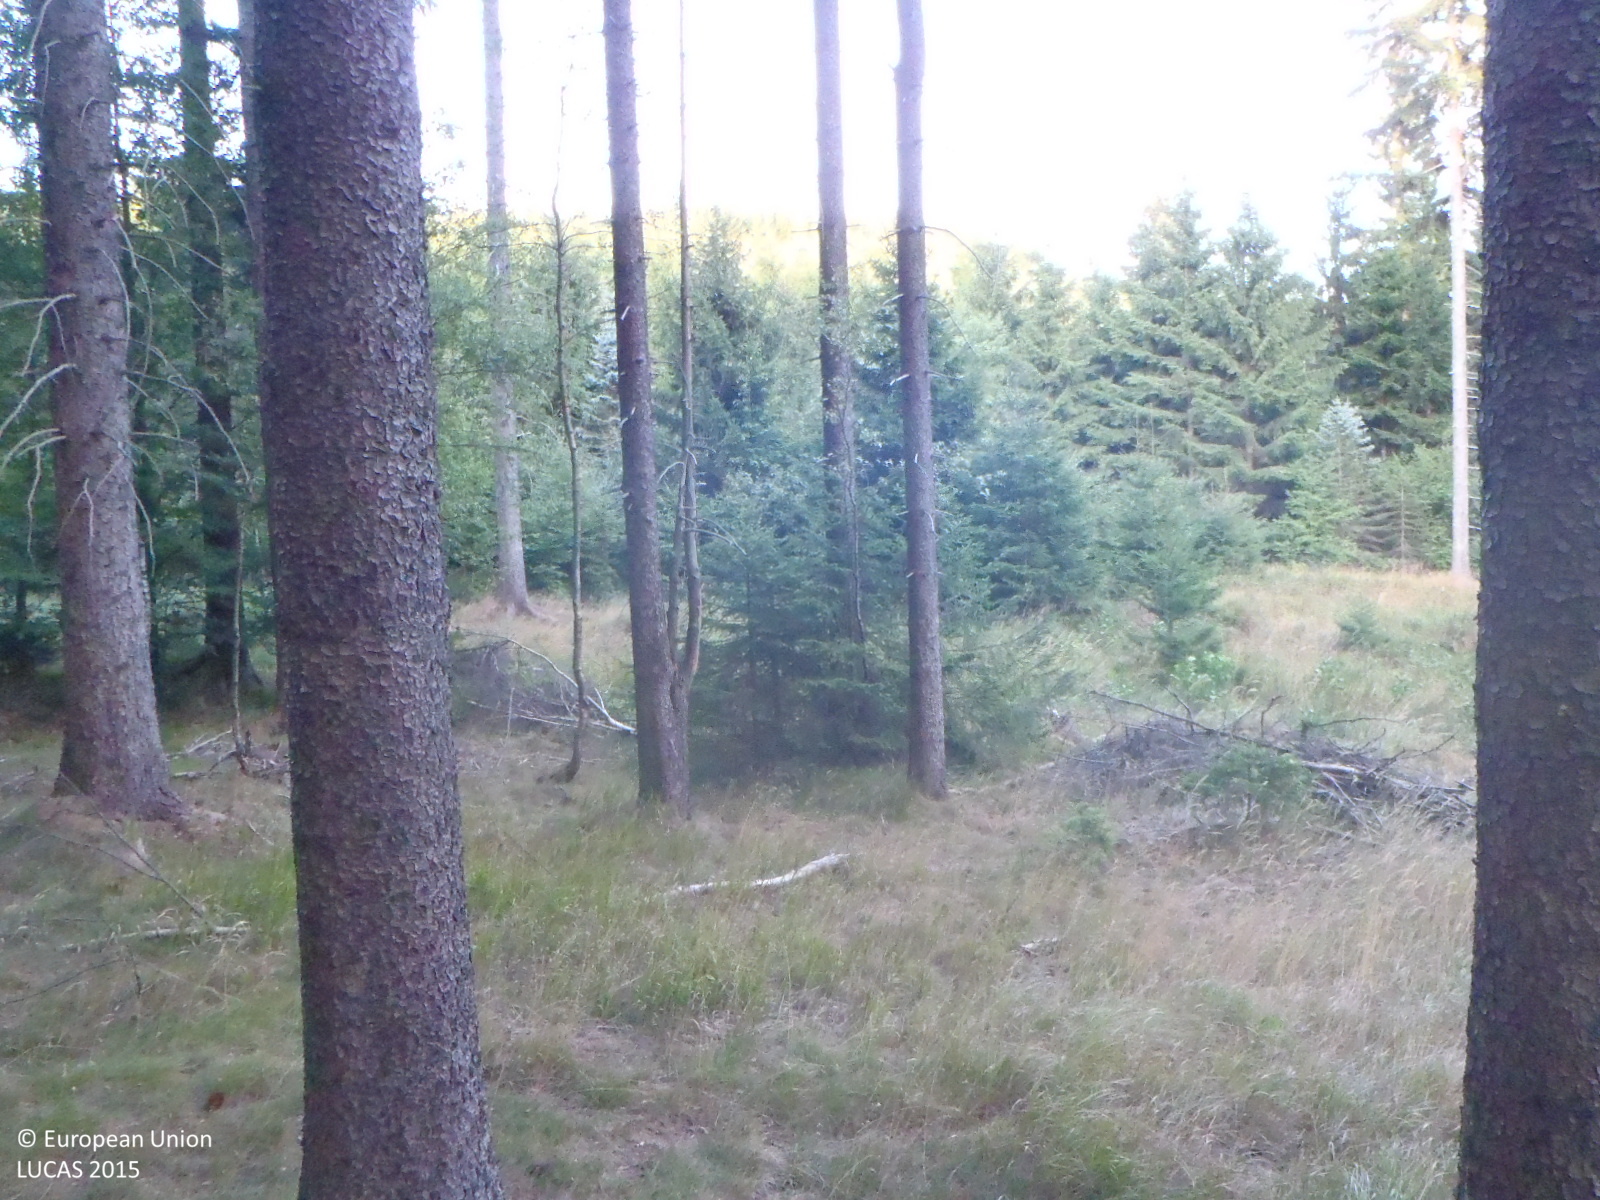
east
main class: Woodland
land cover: Spruce dominated coniferous woodland
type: hemiboreal forest and nemoral coniferous forest and mixed broadleaved-coniferous forest
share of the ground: > 75 %
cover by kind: coniferous forest trees 85 %, broadleaved forest trees 5 %, herbaceous plants 5 %
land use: Forestry
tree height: > 5 m
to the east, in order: Spruce dominated coniferous woodland; Rock outcrops; Spruce dominated coniferous woodland; Spruce dominated mixed woodland; Tracks; Spruce dominated coniferous woodland; Tracks; Spruce dominated coniferous woodland; Broadleaved woodland; Rocks and stones; Spruce dominated mixed woodland; Spruce dominated coniferous woodland; Broadleaved woodland; Spruce dominated coniferous woodland
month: August
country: CZ
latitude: 50.7242
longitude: 14.9750
